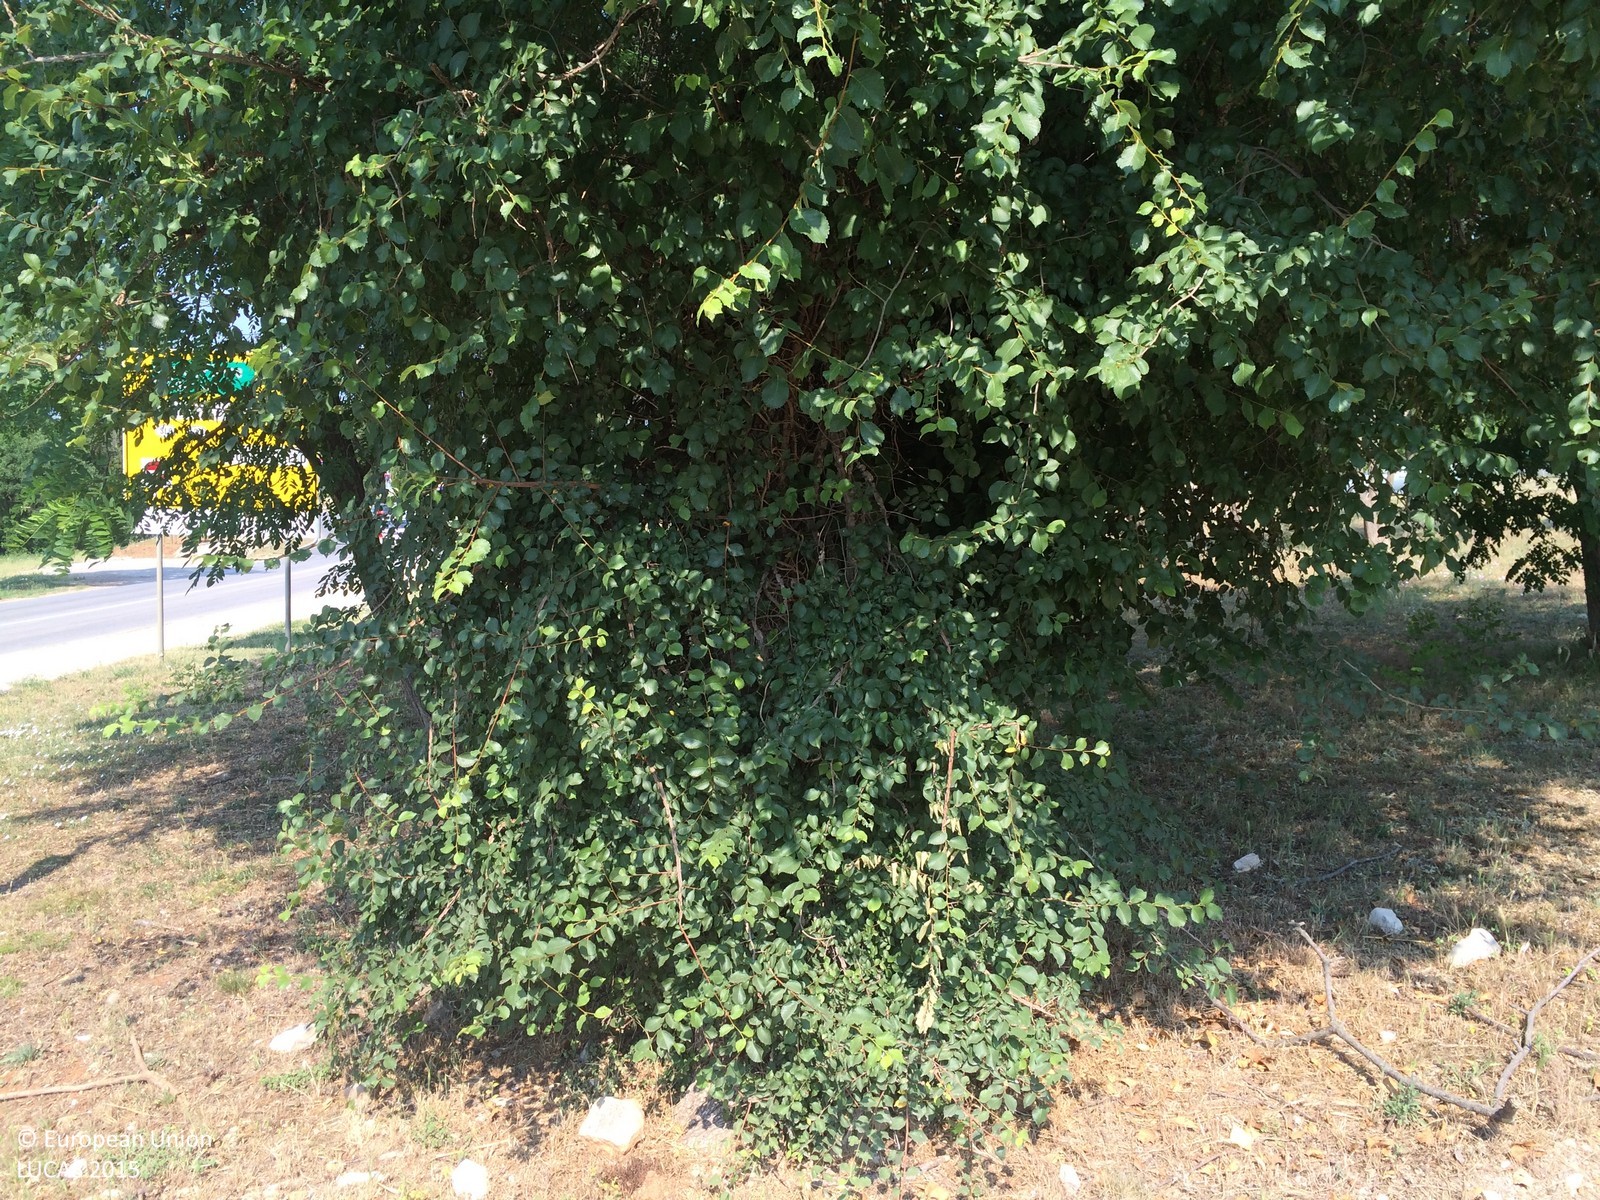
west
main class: Grassland
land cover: Grassland without tree/shrub cover
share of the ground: > 75 %
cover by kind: herbaceous plants 100 %
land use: Residential
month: June
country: HR
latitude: 45.0799
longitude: 13.6659
